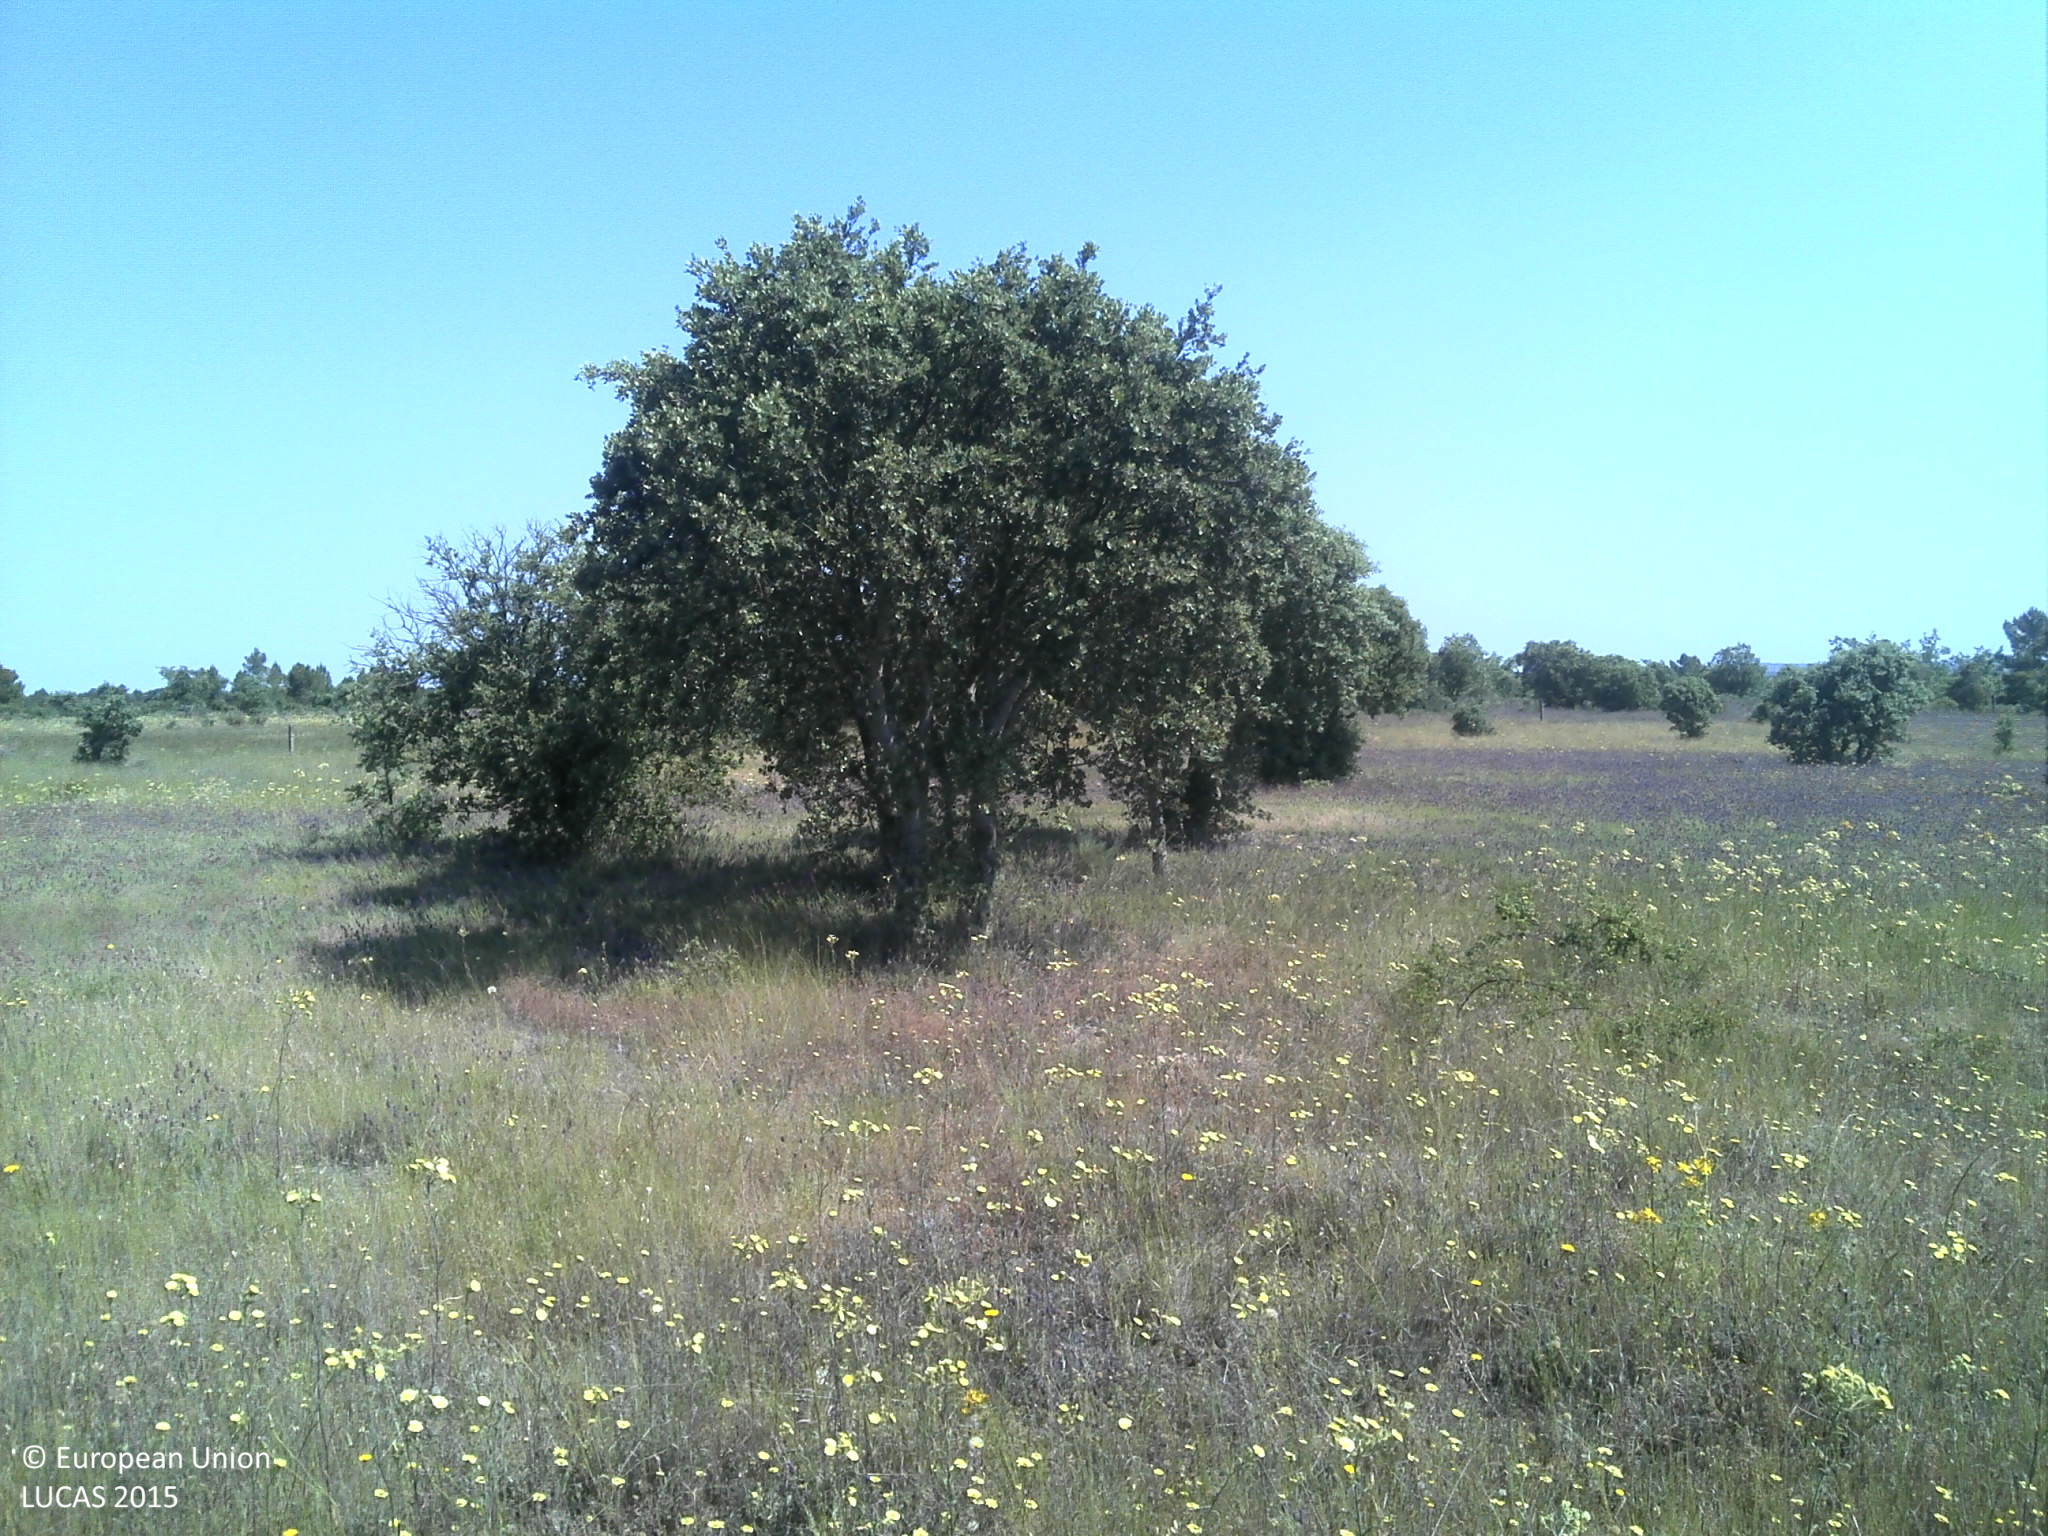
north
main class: Grassland
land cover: Grassland with sparse tree/shrub cover
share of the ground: 50 - 75 %
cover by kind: herbaceous plants 60 %, unconsolidated bare surface 30 %, broadleaved forest trees 5 %
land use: Agriculture (excluding fallow land and kitchen gardens)
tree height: > 5 m
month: June
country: PT
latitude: 40.5310
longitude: -6.8474
